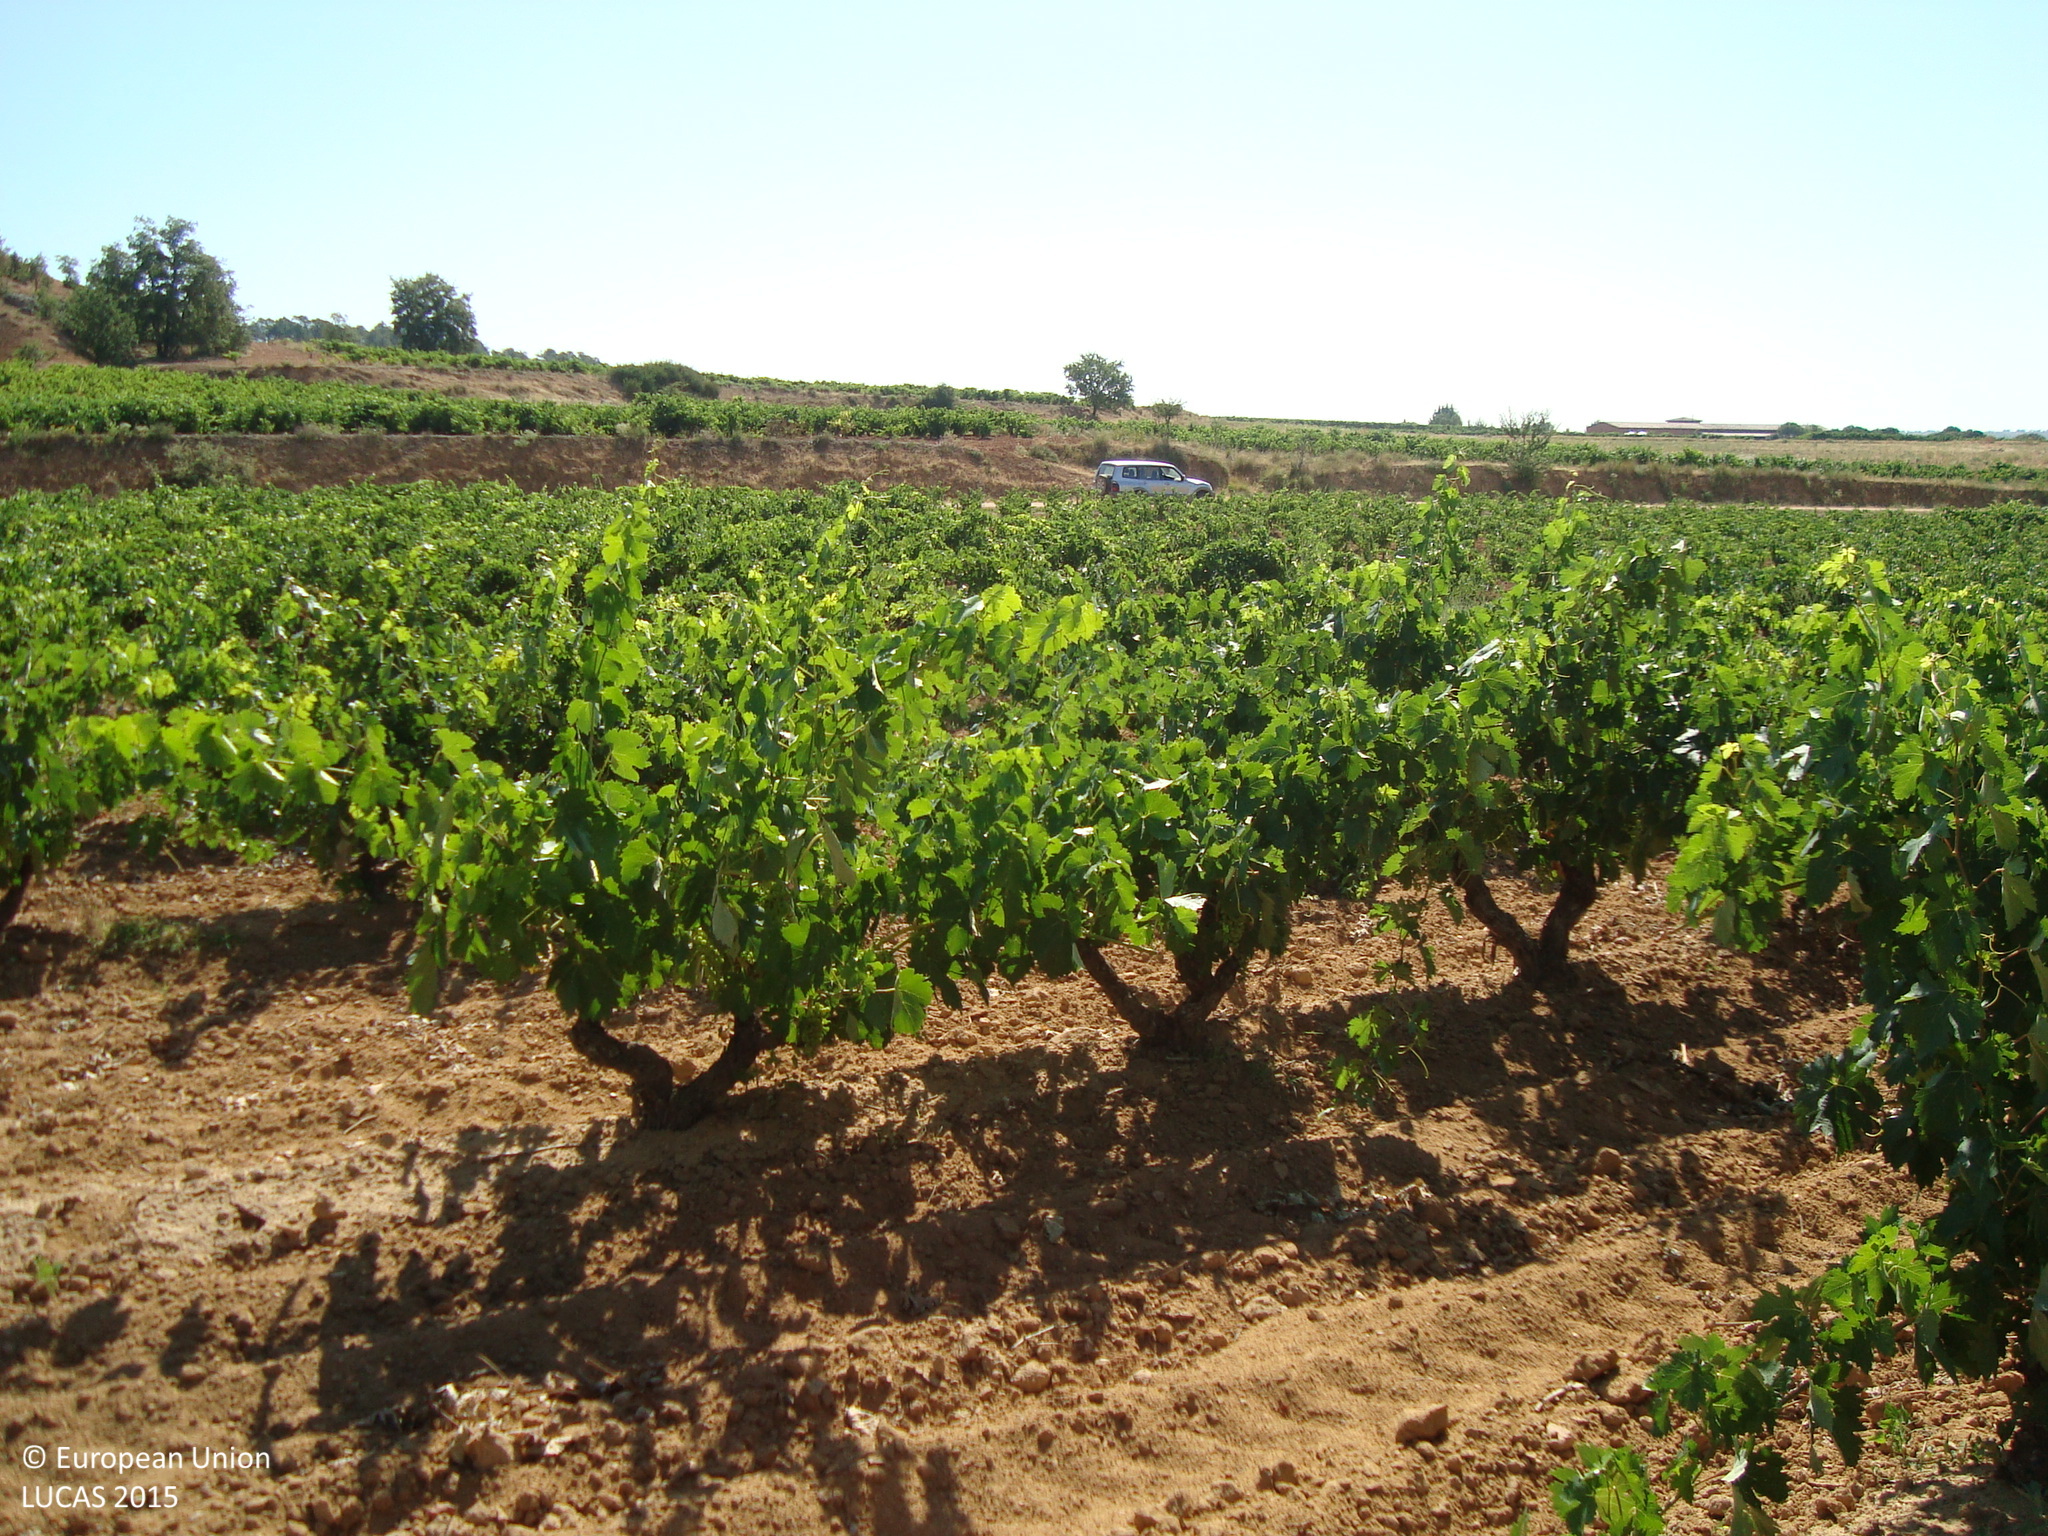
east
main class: Cropland
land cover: Vineyards
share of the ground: 25 - 50 %
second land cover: Other bare soil
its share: > 75 %
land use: Agriculture (excluding fallow land and kitchen gardens)
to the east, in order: Vineyards; Other bare soil; Grass margins; Tracks; Grass margins; Vineyards; Grass margins; Grassland without tree/shrub cover; Vineyards; Grassland without tree/shrub cover; Grassland with sparse tree/shrub cover; Vineyards
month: July
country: ES
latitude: 41.7654
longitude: -3.7555
